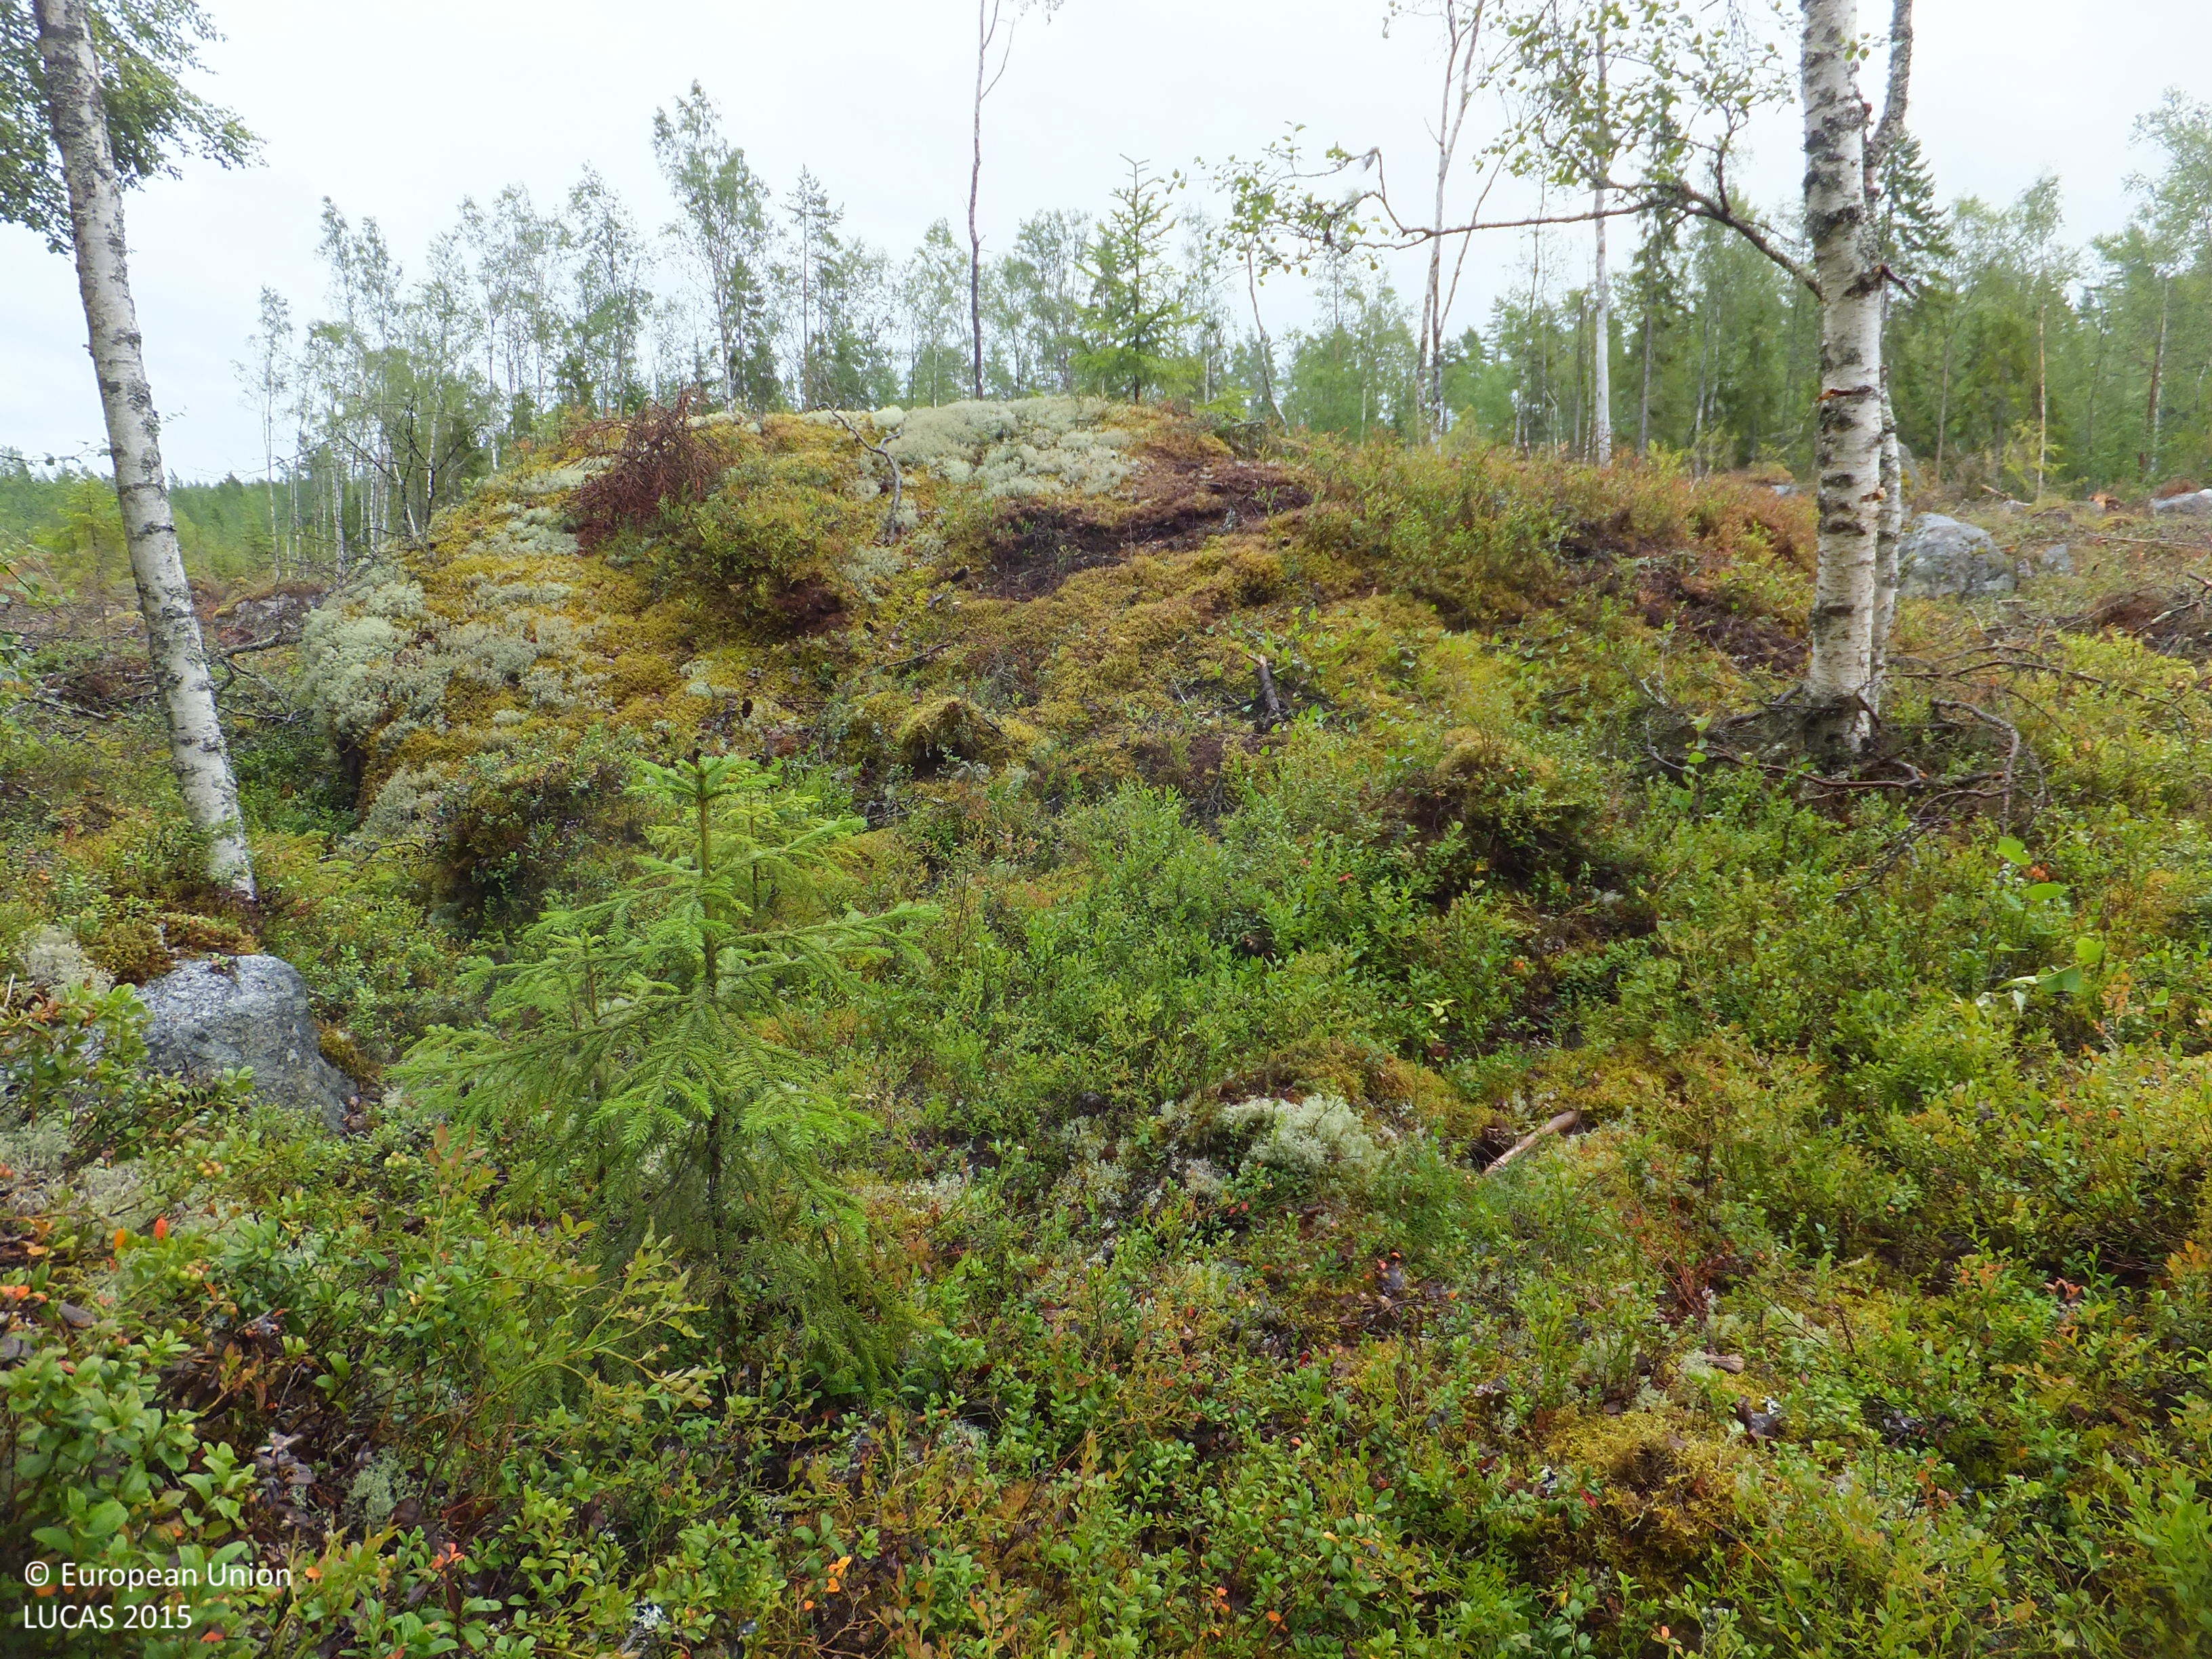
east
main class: Woodland
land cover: Other mixed woodland
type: boreal forest
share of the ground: 50 - 75 %
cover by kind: coniferous forest trees 30 %, broadleaved forest trees 30 %, shrubs 20 %, lichens and mosses 10 %, consolidated bare surface 10 %
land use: Forestry
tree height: > 5 m
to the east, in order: Other mixed woodland; Shrubland with sparse tree cover; Other mixed woodland; Inland marshes; Spruce dominated mixed woodland; Ditches and canals; Spruce dominated mixed woodland; Shrubland without tree cover; Pine dominated coniferous woodland
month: July
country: FI
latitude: 63.2426
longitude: 21.8072
